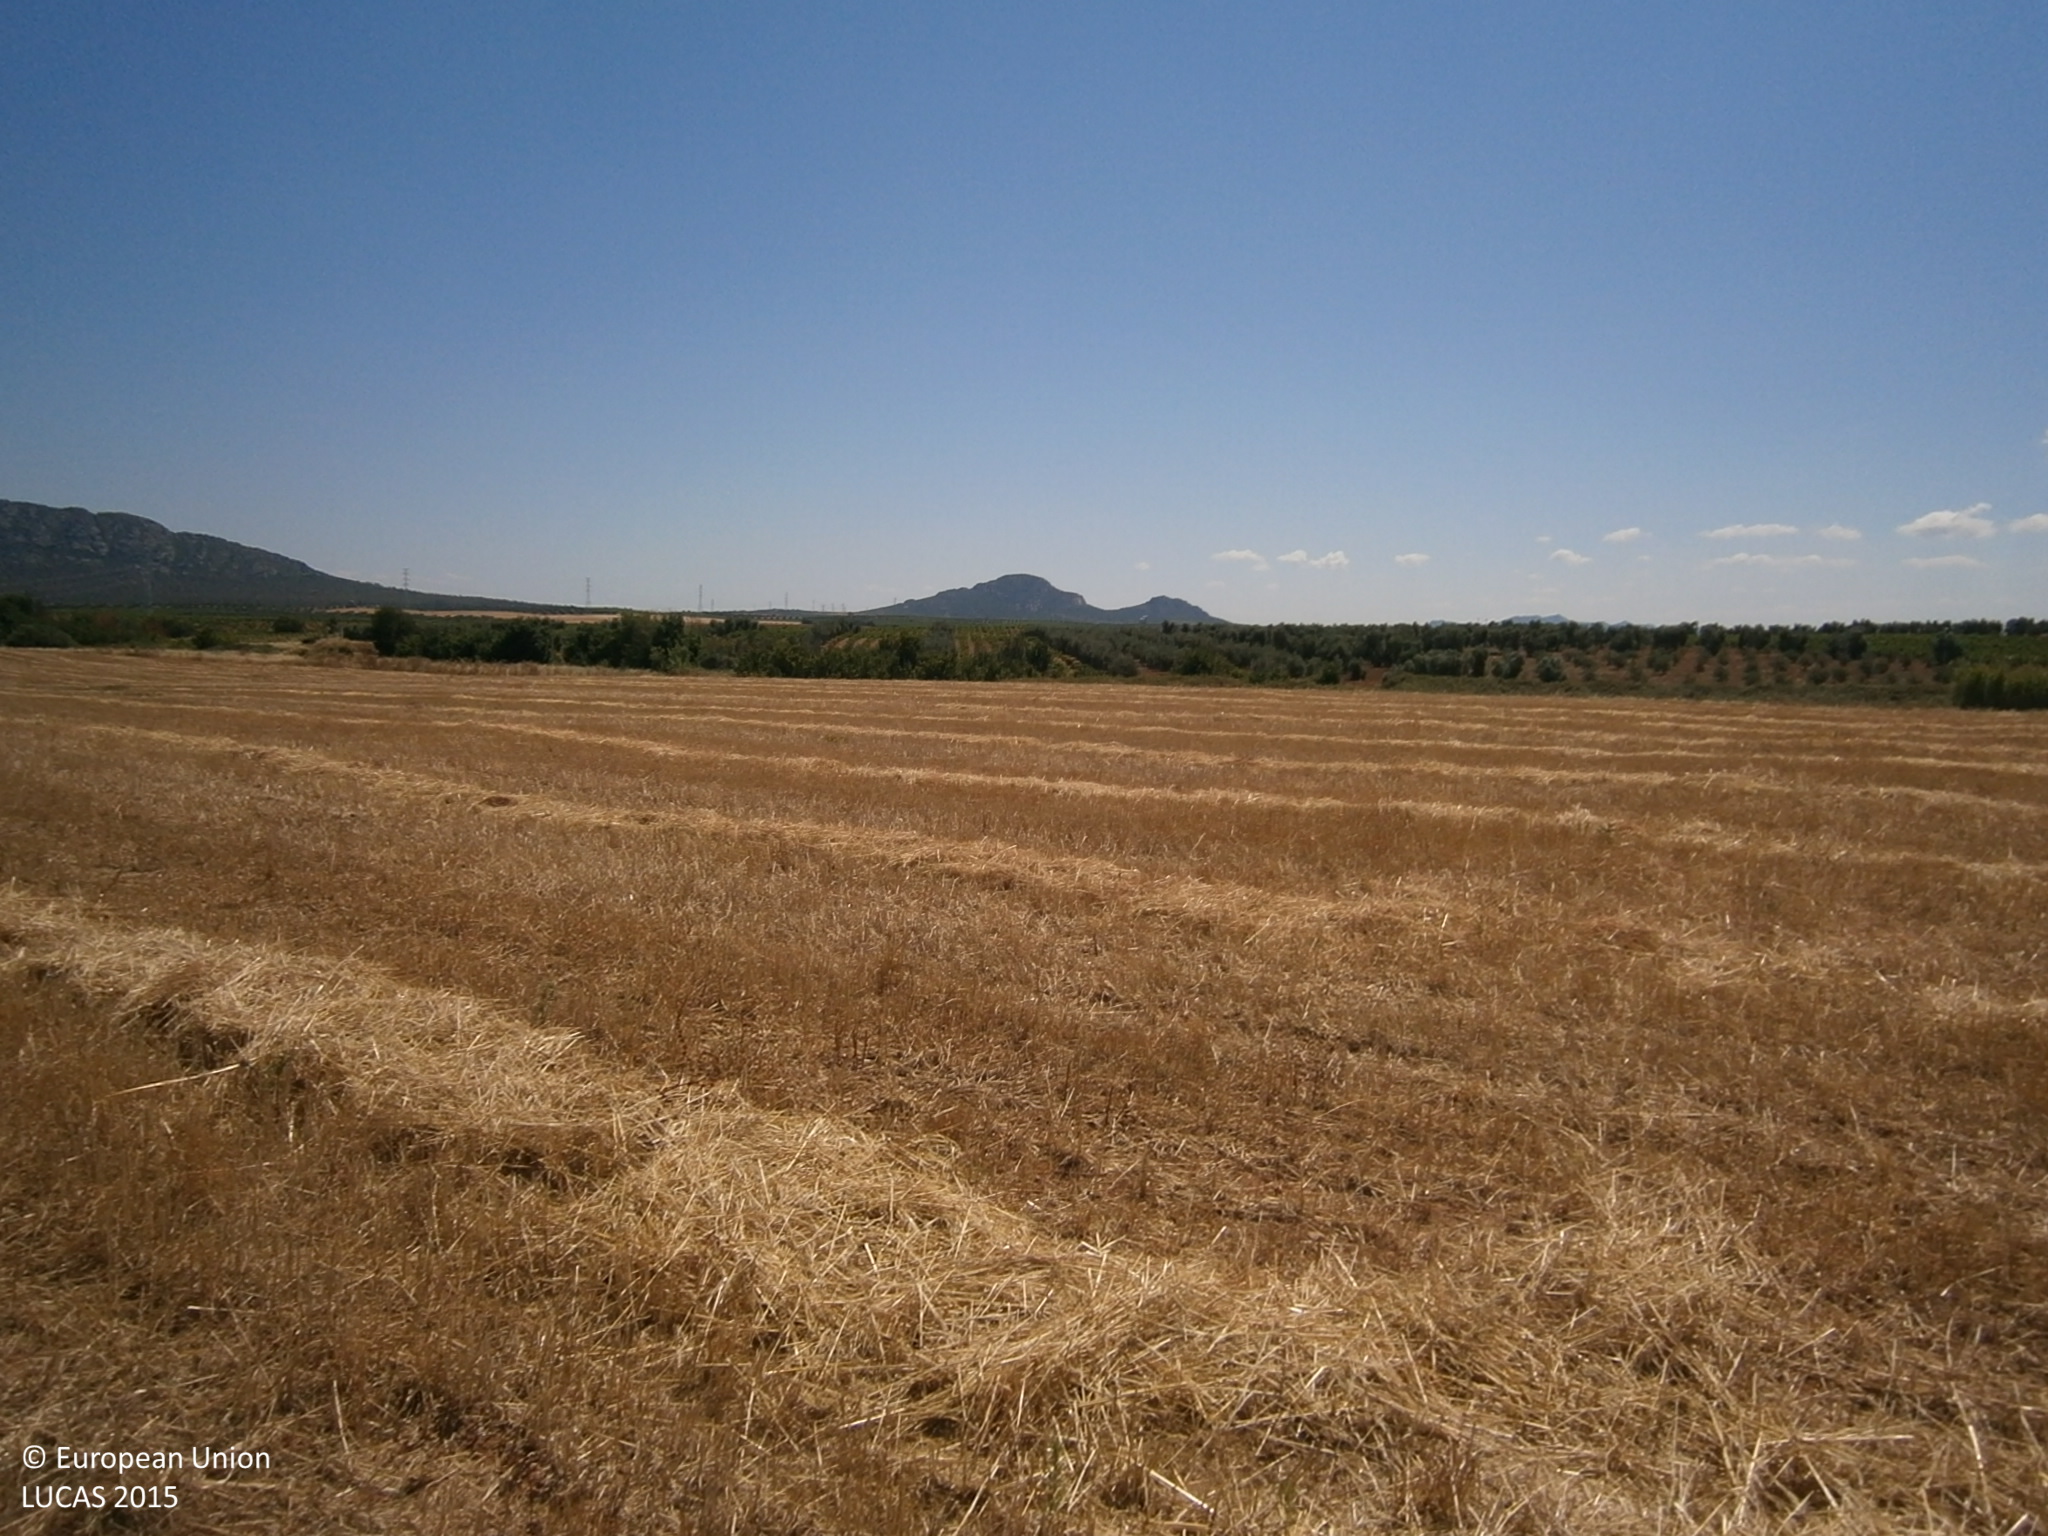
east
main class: Cropland
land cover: Oats
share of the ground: > 75 %
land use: Agriculture (excluding fallow land and kitchen gardens)
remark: Harvested field
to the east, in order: Oats; Shrubland without tree cover; Rivers and streams; Shrubland without tree cover; Olive groves
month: June
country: ES
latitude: 38.7997
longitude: -6.4189
